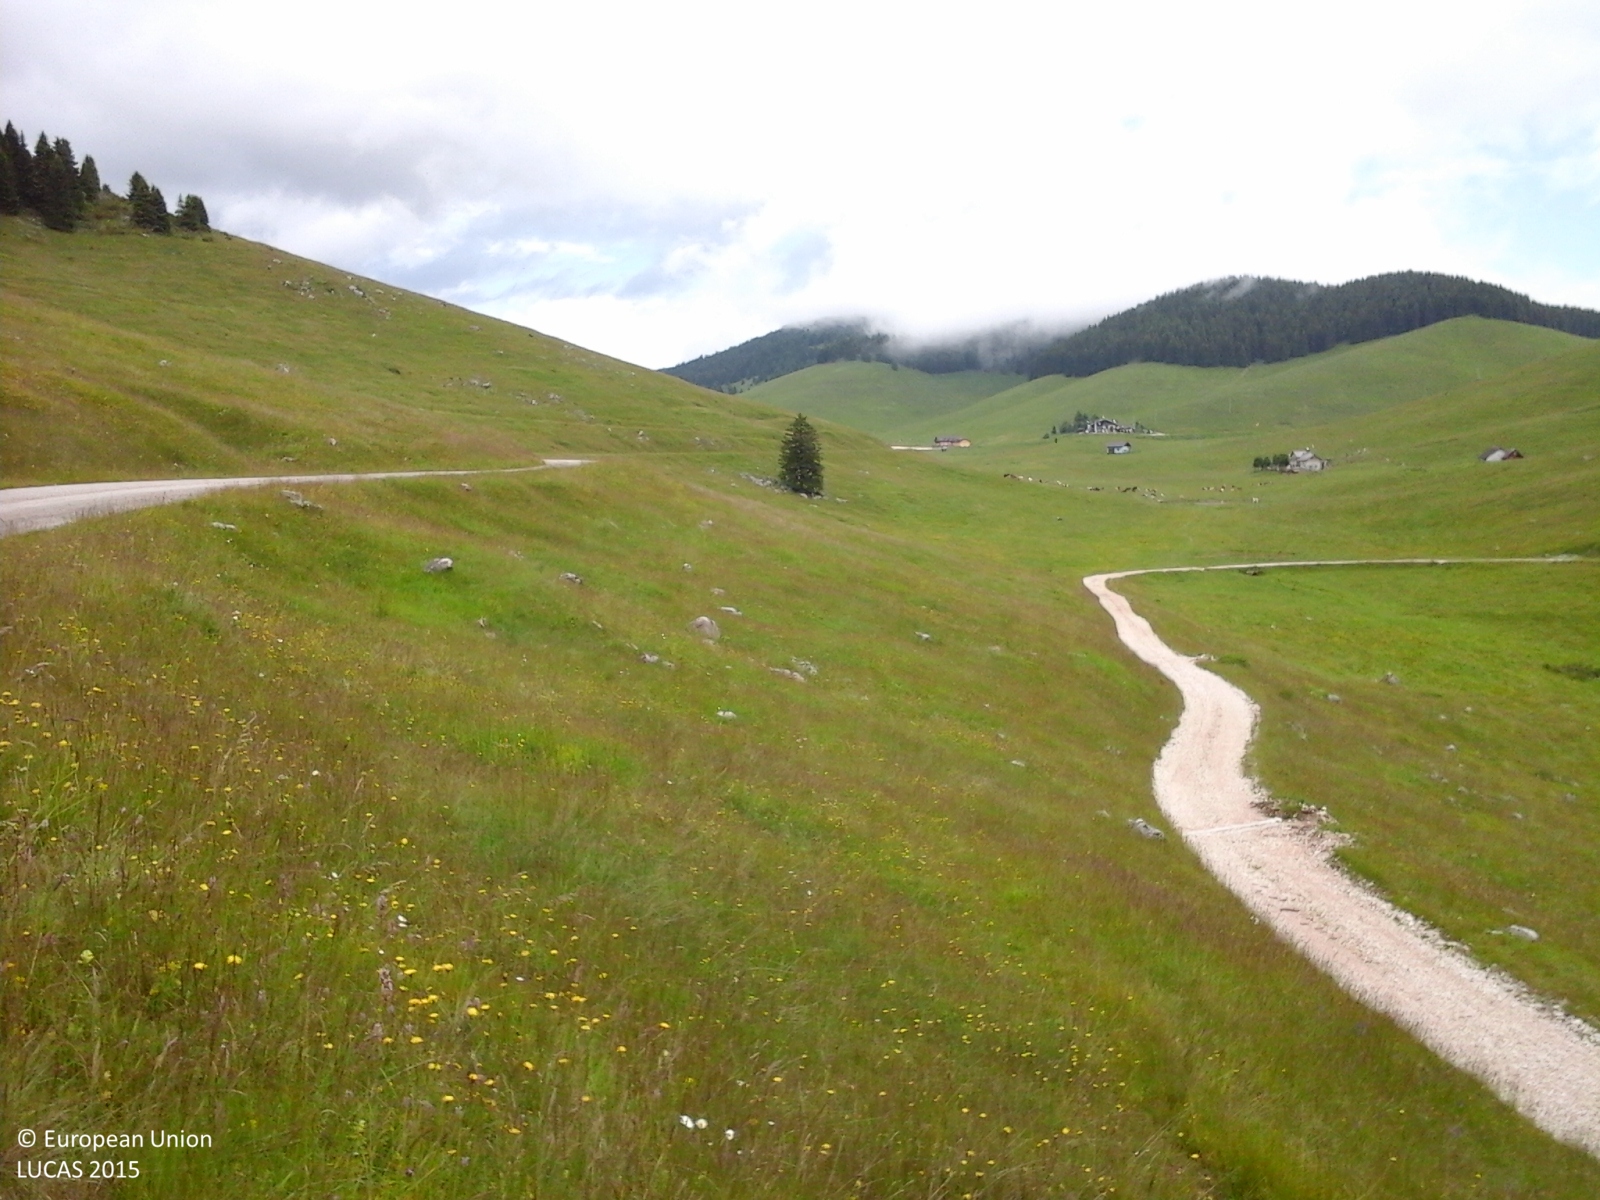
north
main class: Grassland
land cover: Grassland without tree/shrub cover
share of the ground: > 75 %
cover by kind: herbaceous plants 100 %
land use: Agriculture (excluding fallow land and kitchen gardens)
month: June
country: IT
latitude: 45.9423
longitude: 11.6358
